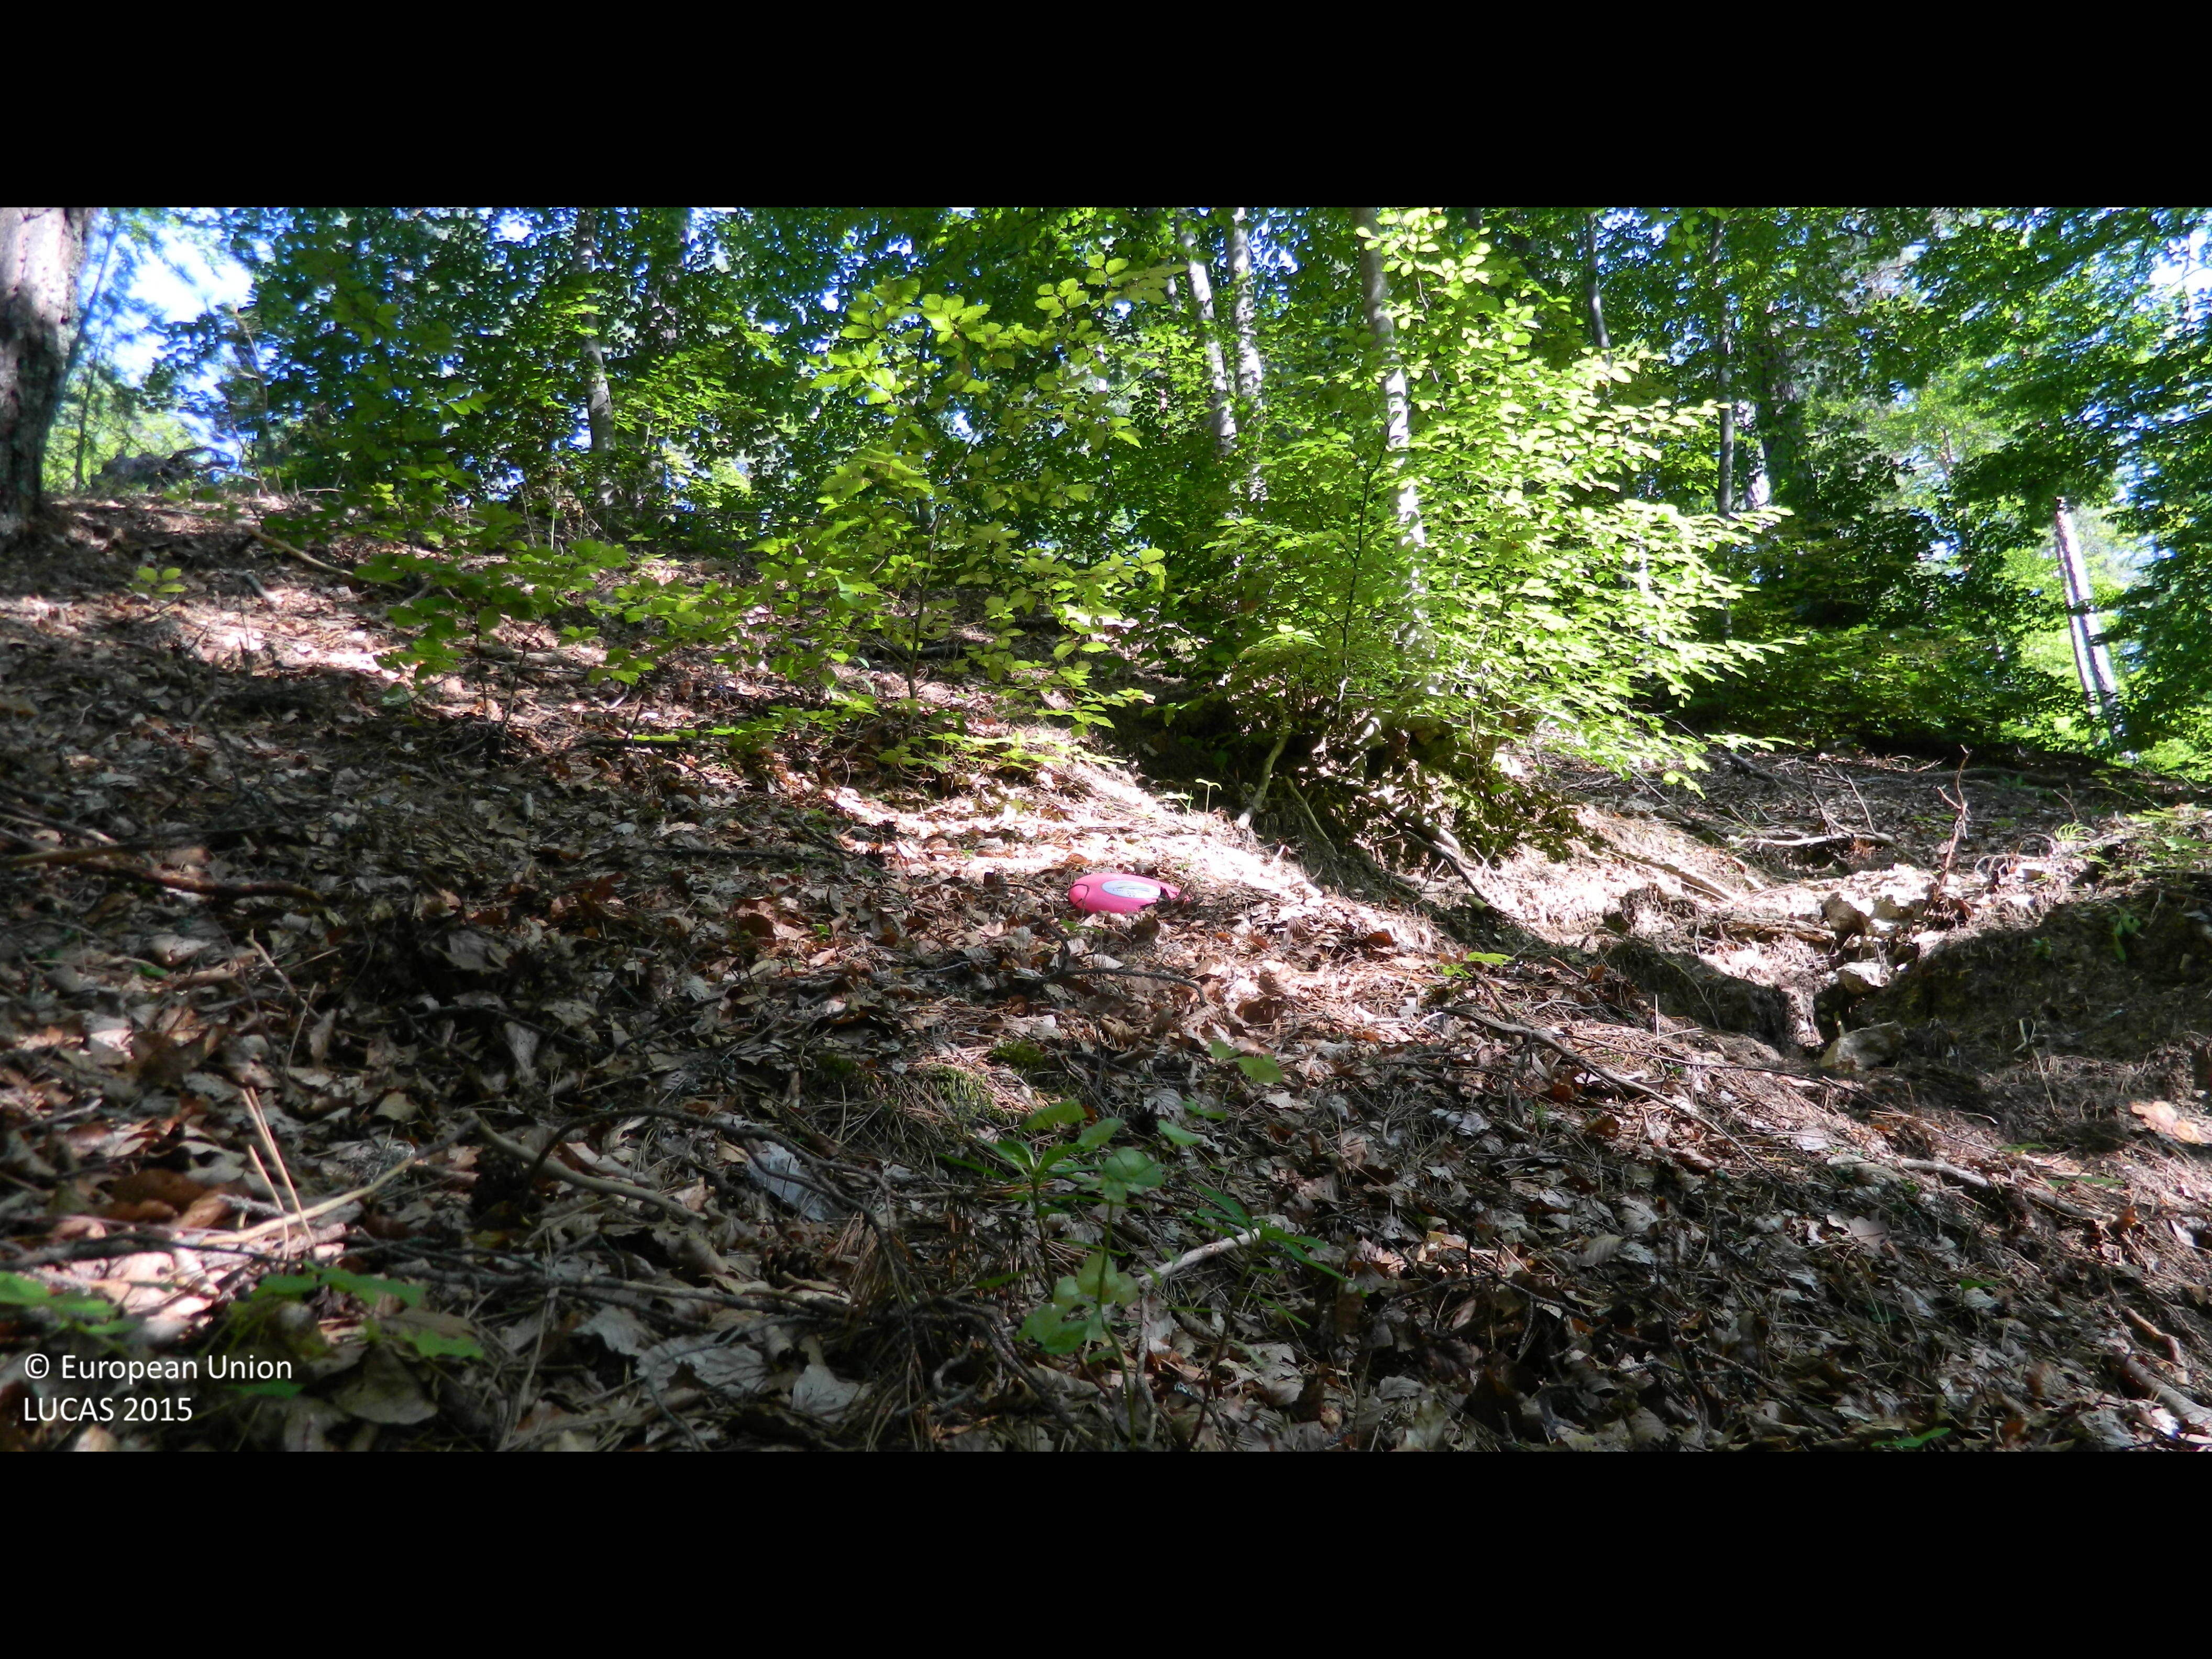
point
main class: Woodland
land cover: Broadleaved woodland
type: mountainous beech forest
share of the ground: > 75 %
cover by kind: broadleaved forest trees 85 %, coniferous forest trees 10 %, unconsolidated bare surface 5 %
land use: Forestry
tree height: > 5 m
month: July
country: BG
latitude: 41.5413
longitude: 24.8012
